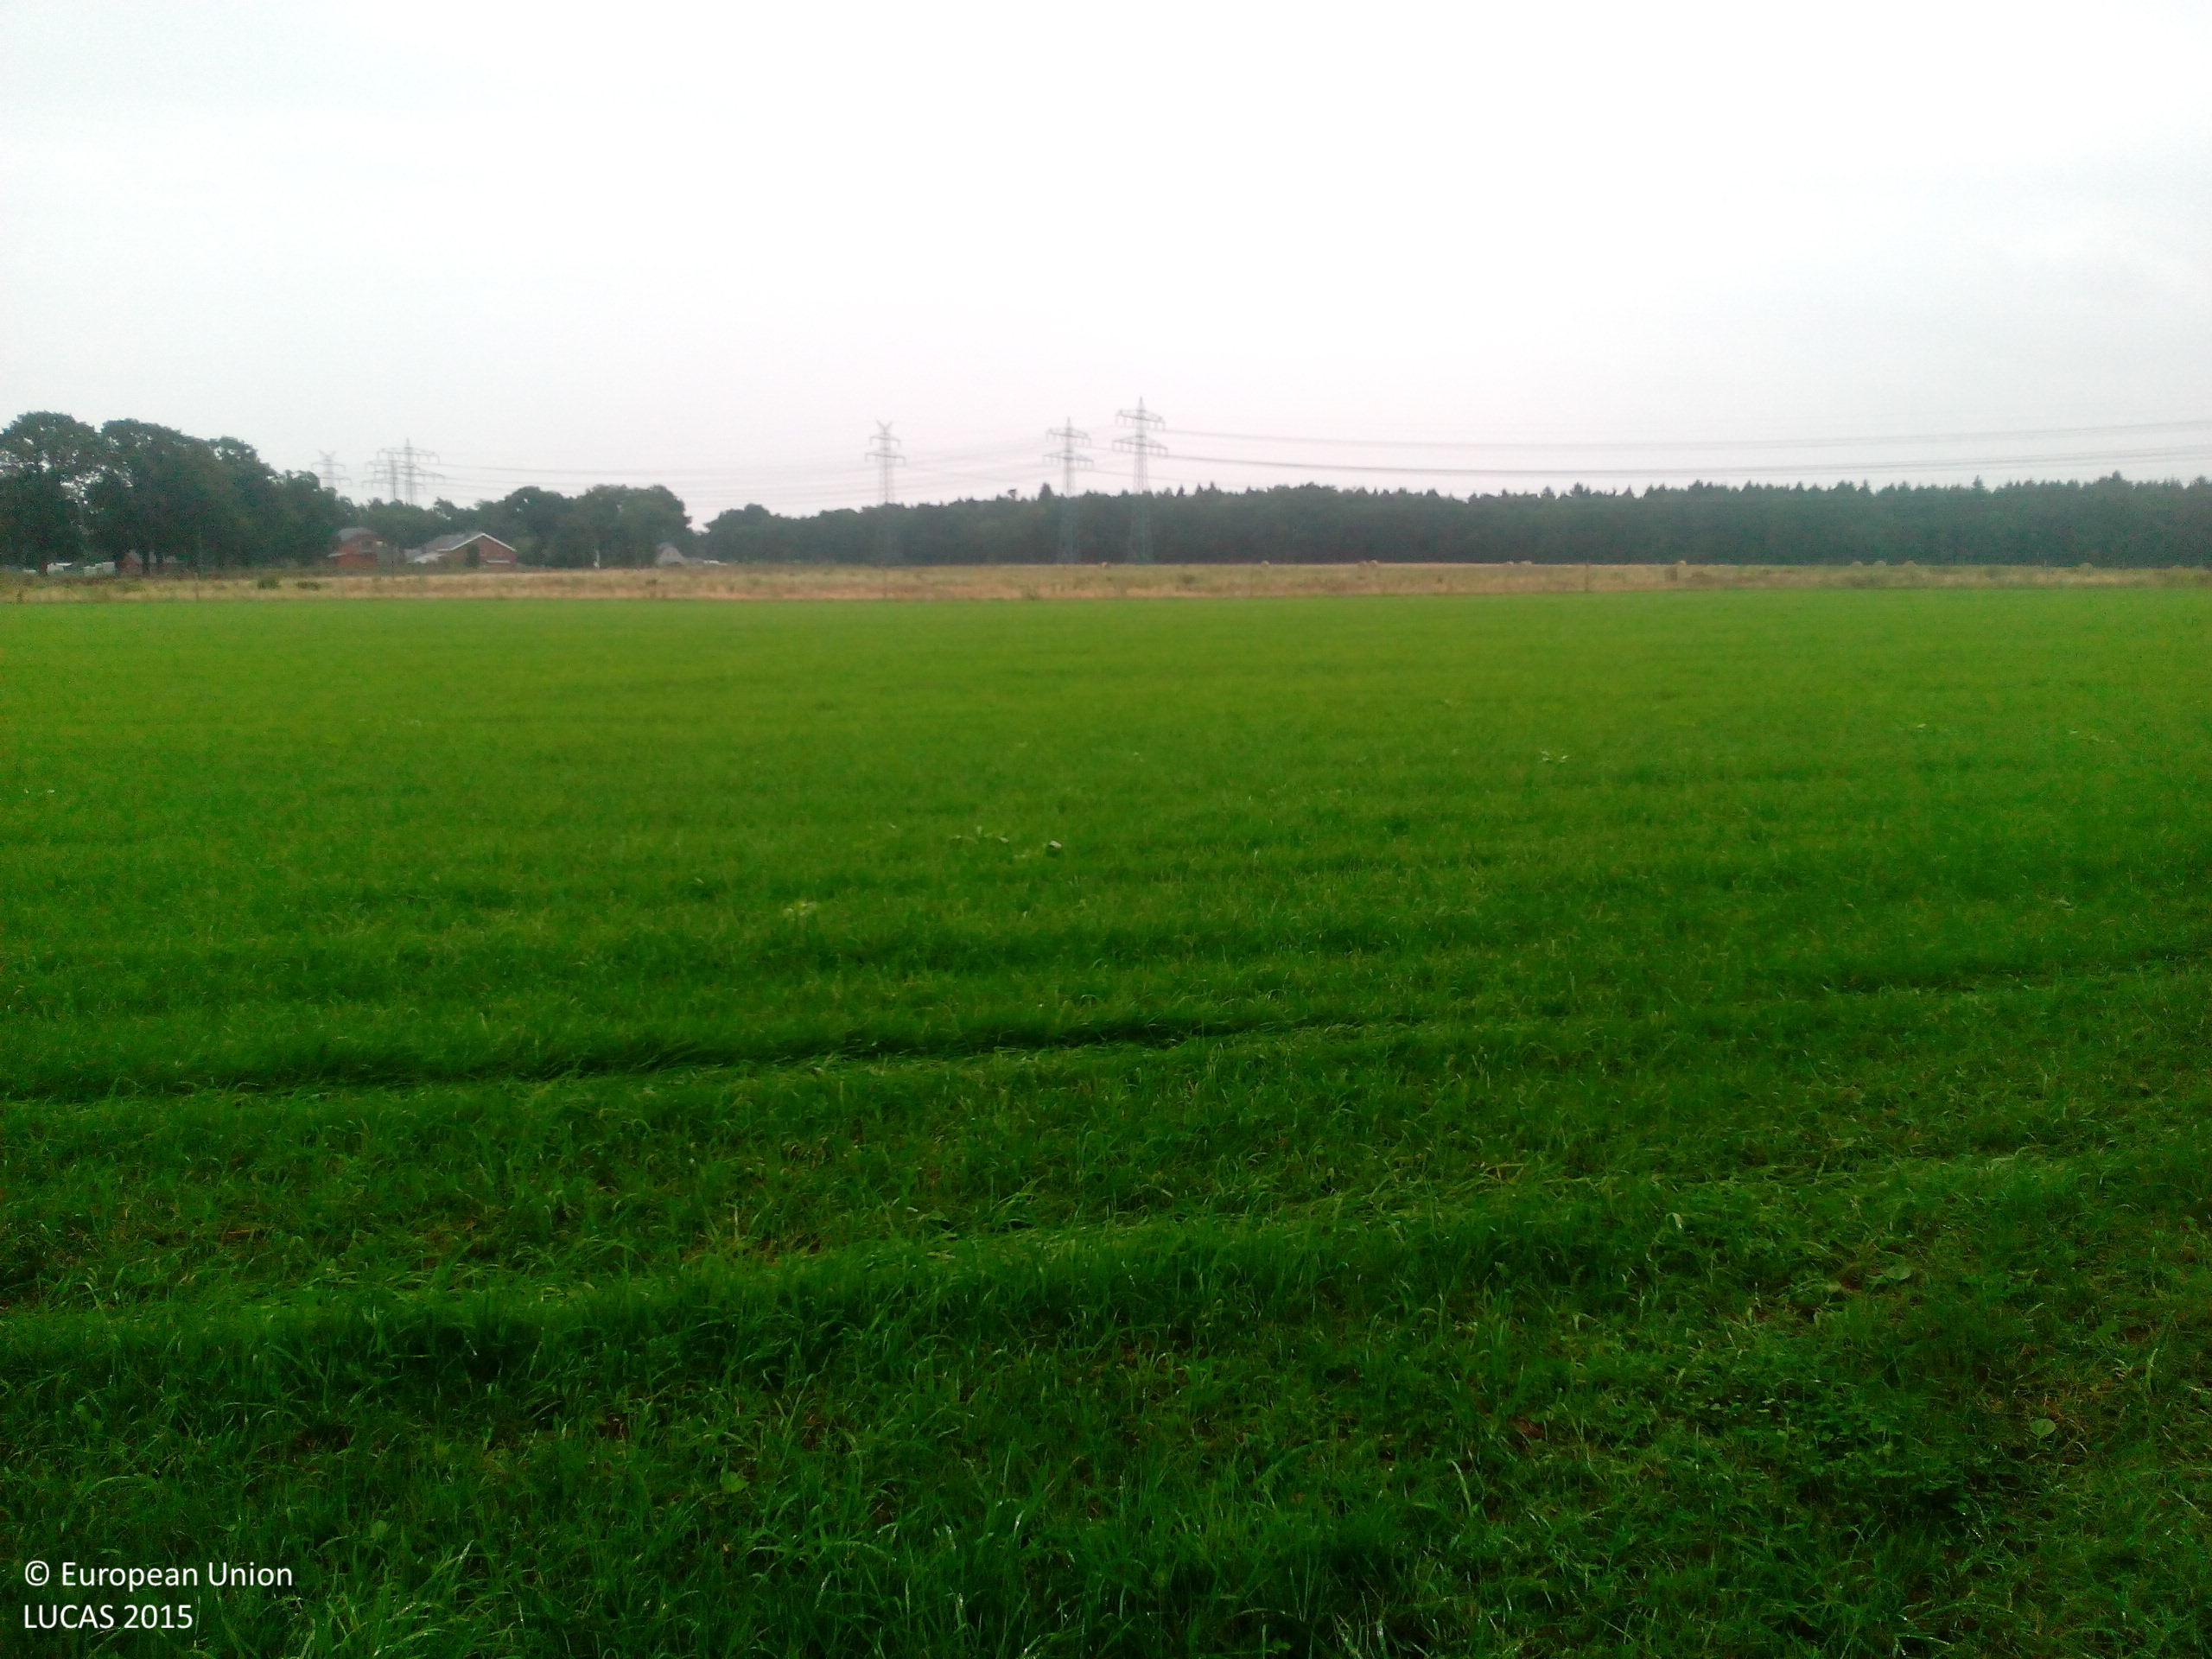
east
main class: Grassland
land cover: Grassland without tree/shrub cover
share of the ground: > 75 %
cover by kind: herbaceous plants 100 %
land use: Agriculture (excluding fallow land and kitchen gardens)
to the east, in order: Grassland without tree/shrub cover; Fences; Spontaneously vegetated surfaces
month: August
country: DE
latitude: 53.7254
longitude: 9.9546
